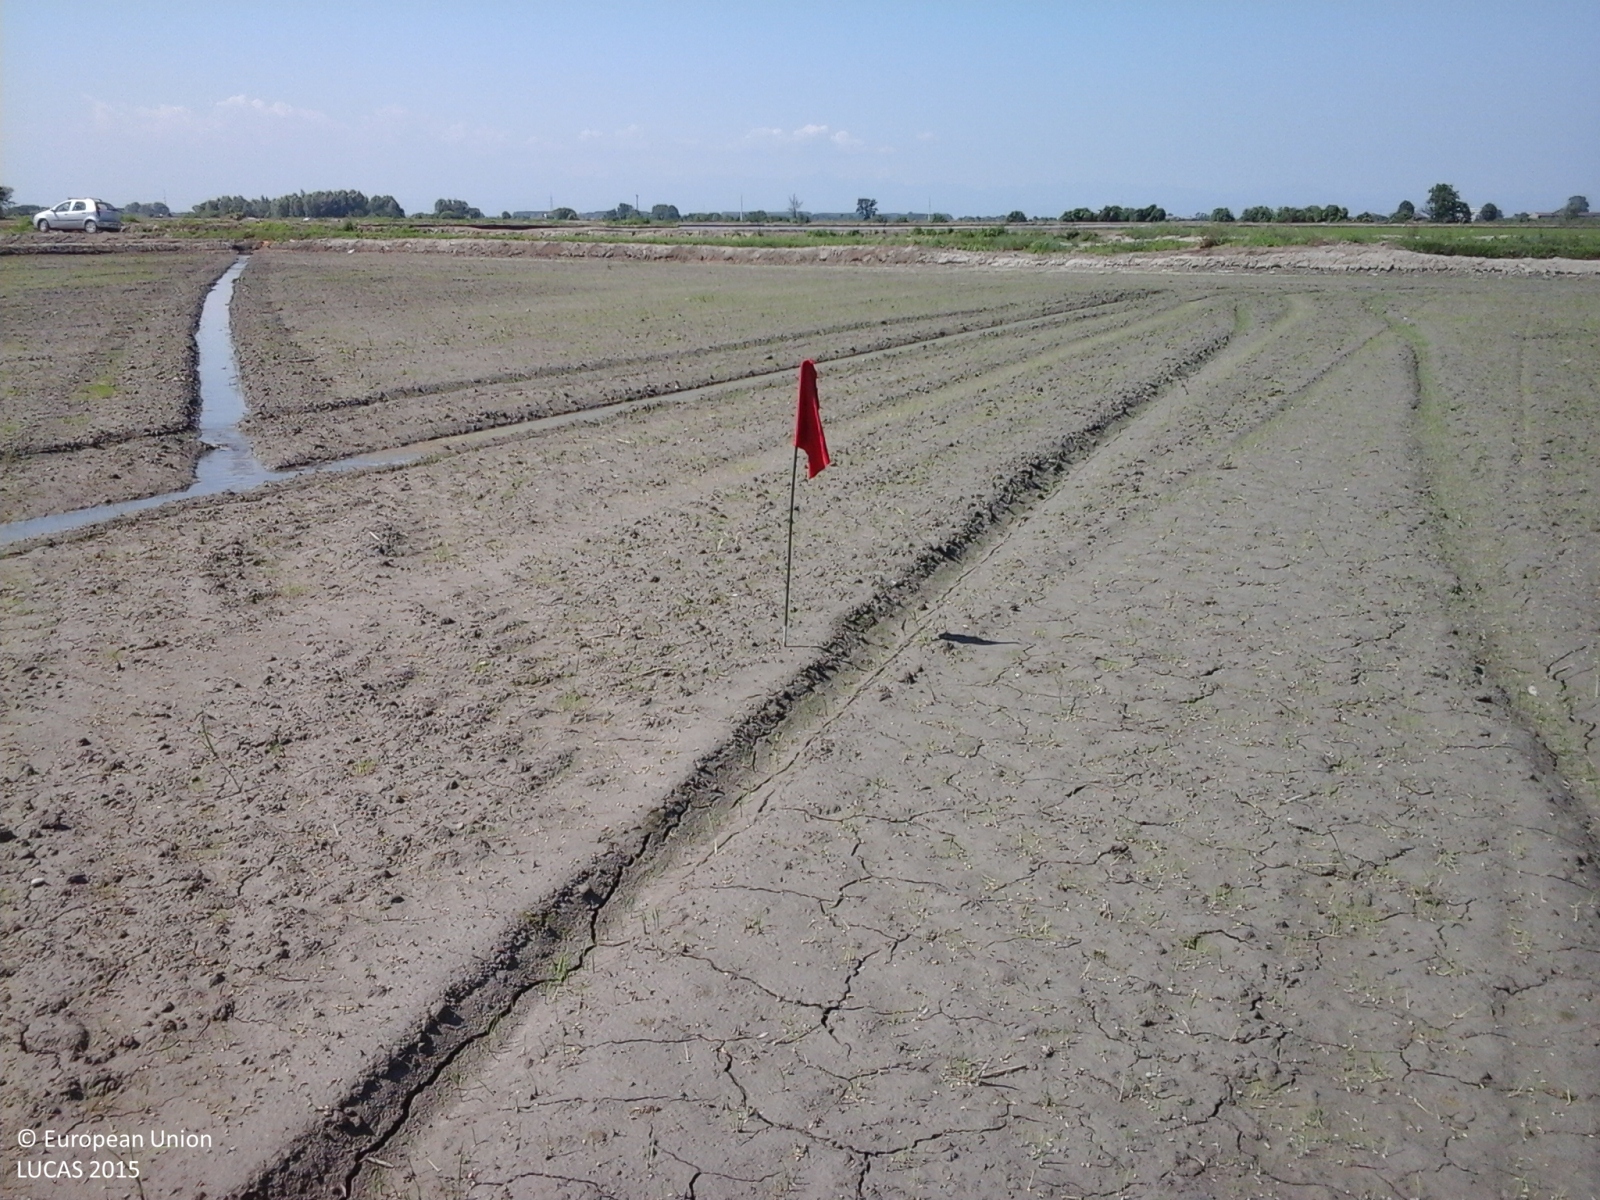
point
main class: Cropland
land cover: Rice
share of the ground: < 10 %
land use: Agriculture (excluding fallow land and kitchen gardens)
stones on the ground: < 10 %
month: May
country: IT
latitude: 45.2577
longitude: 8.3845
